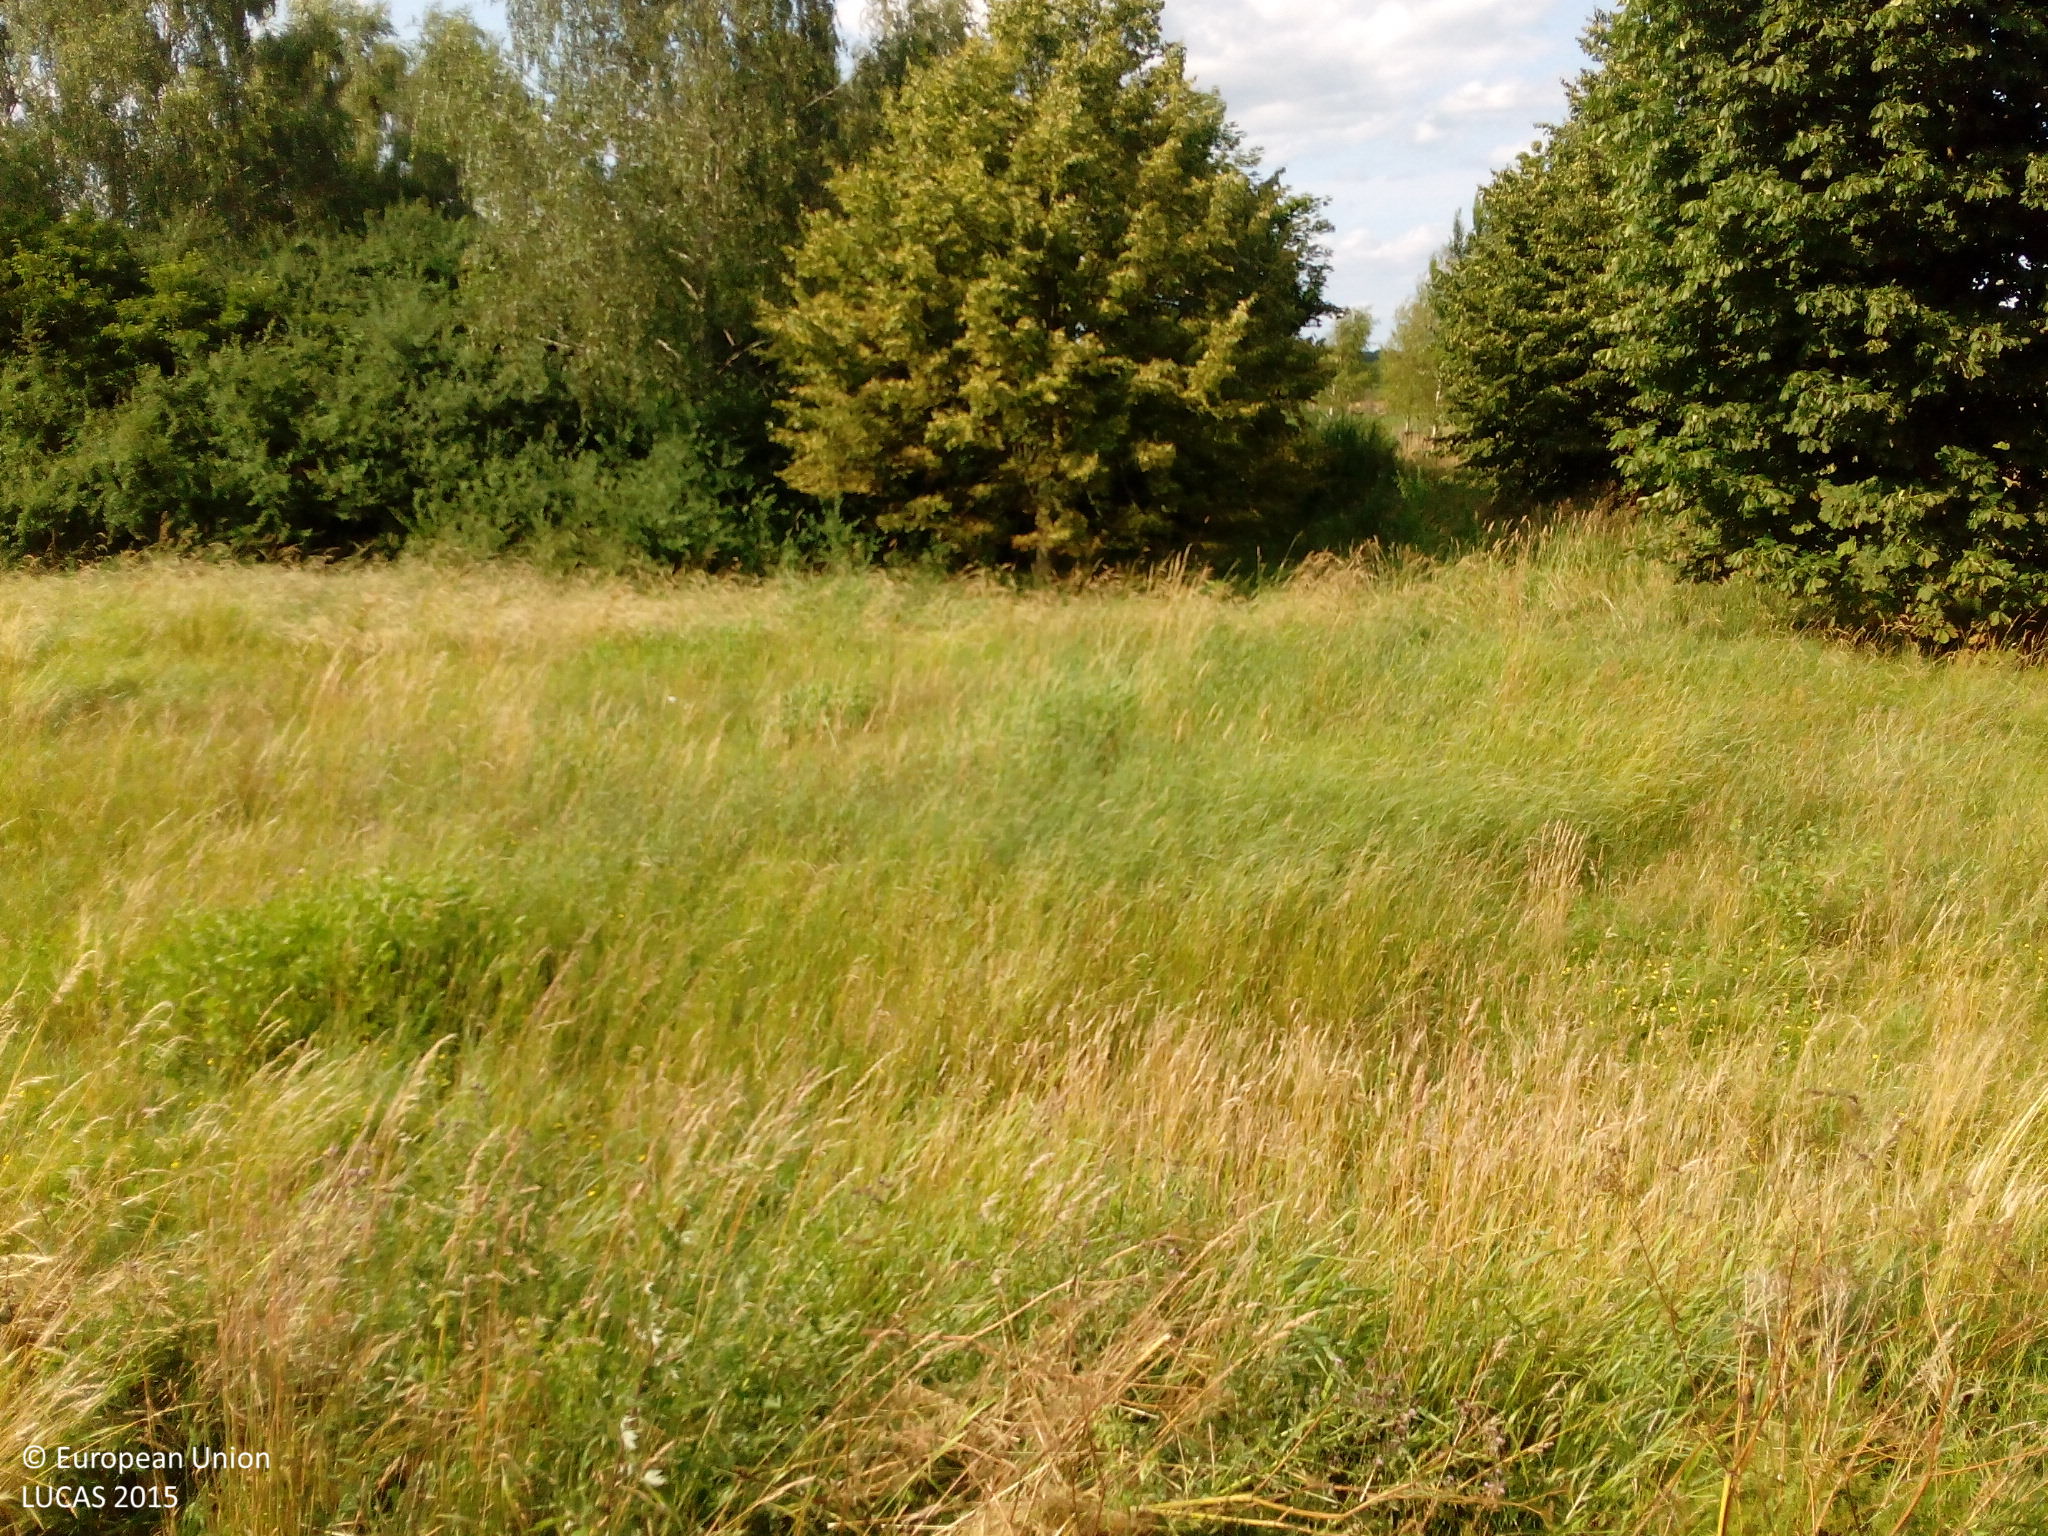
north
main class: Grassland
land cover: Grassland without tree/shrub cover
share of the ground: > 75 %
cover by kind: herbaceous plants 75 %, consolidated bare surface 25 %
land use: Road transport
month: July
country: DE
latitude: 53.4551
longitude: 14.2022
